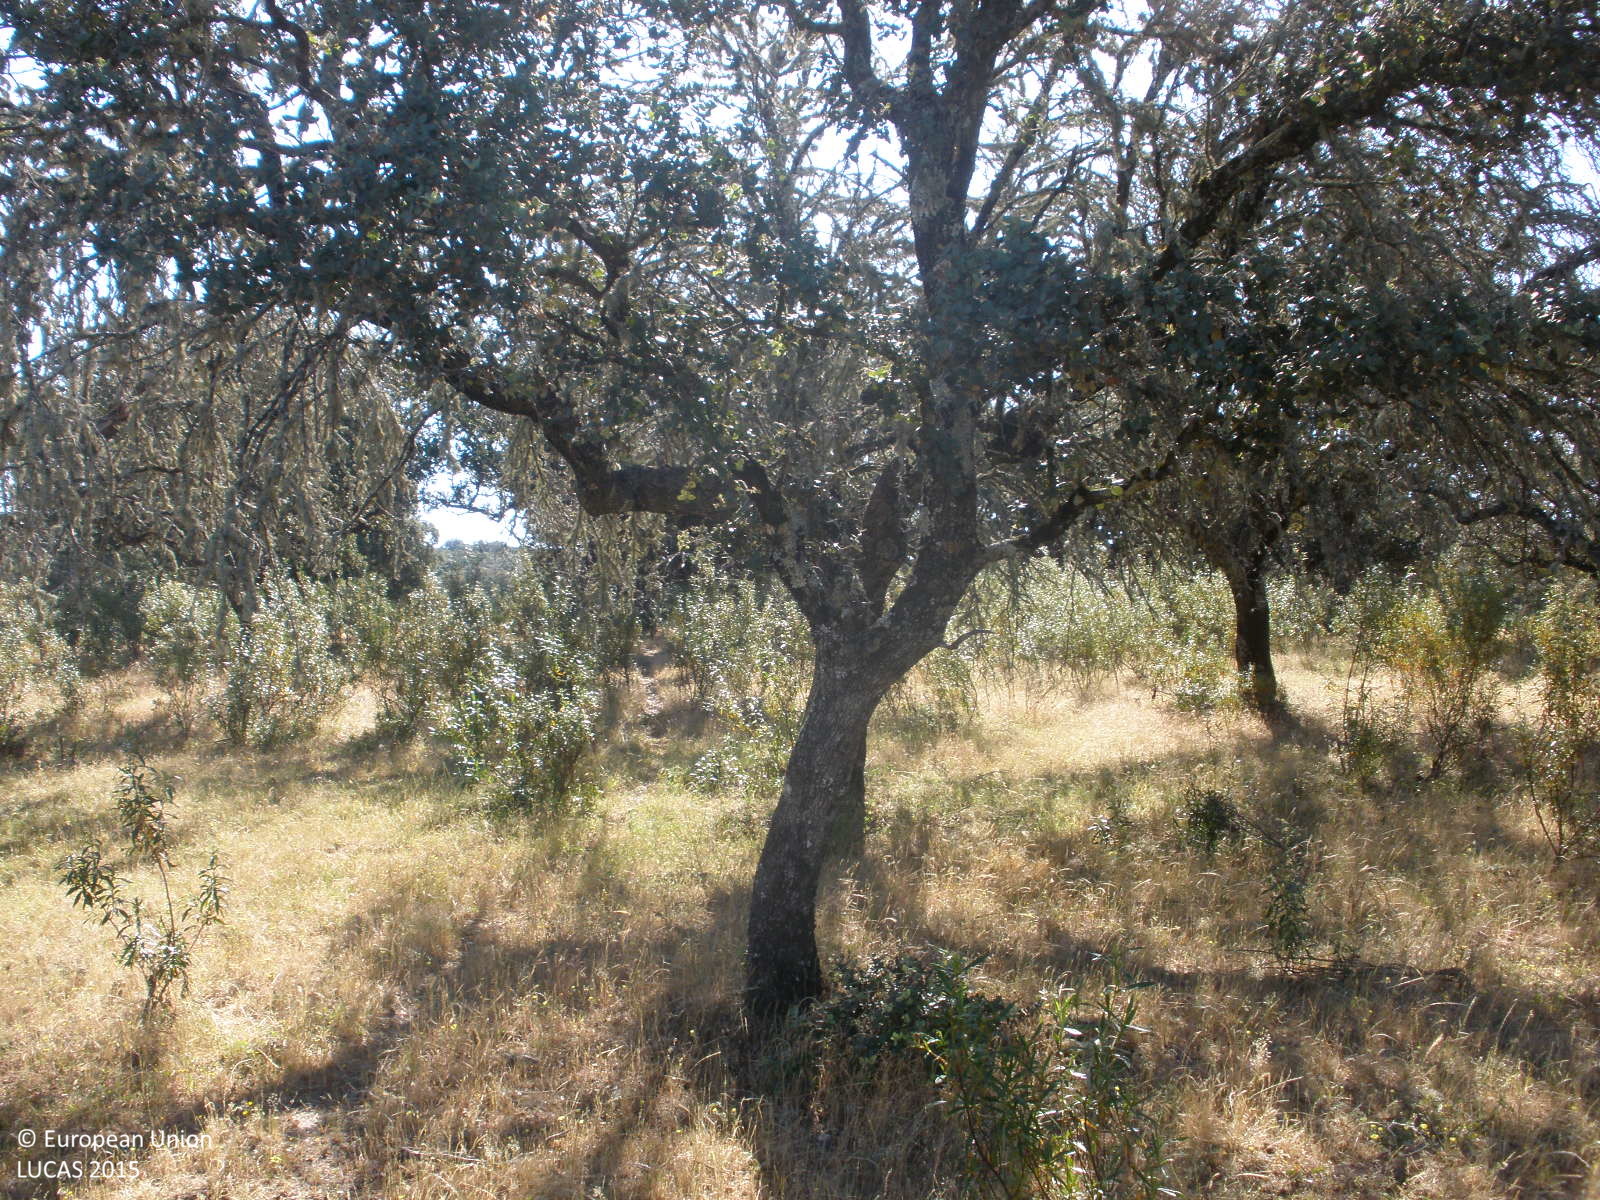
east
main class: Woodland
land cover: Broadleaved woodland
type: broadleaved evergreen forest
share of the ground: 50 - 75 %
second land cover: Grassland without tree/shrub cover
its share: > 75 %
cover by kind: herbaceous plants 60 %, broadleaved forest trees 35 %, shrubs 5 %
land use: Forestry
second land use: Agriculture (excluding fallow land and kitchen gardens)
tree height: < 5 m
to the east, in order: Broadleaved woodland; Grassland without tree/shrub cover; Tracks; Broadleaved woodland; Grassland without tree/shrub cover; Broadleaved woodland
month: May
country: ES
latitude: 40.2260
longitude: -6.2607
